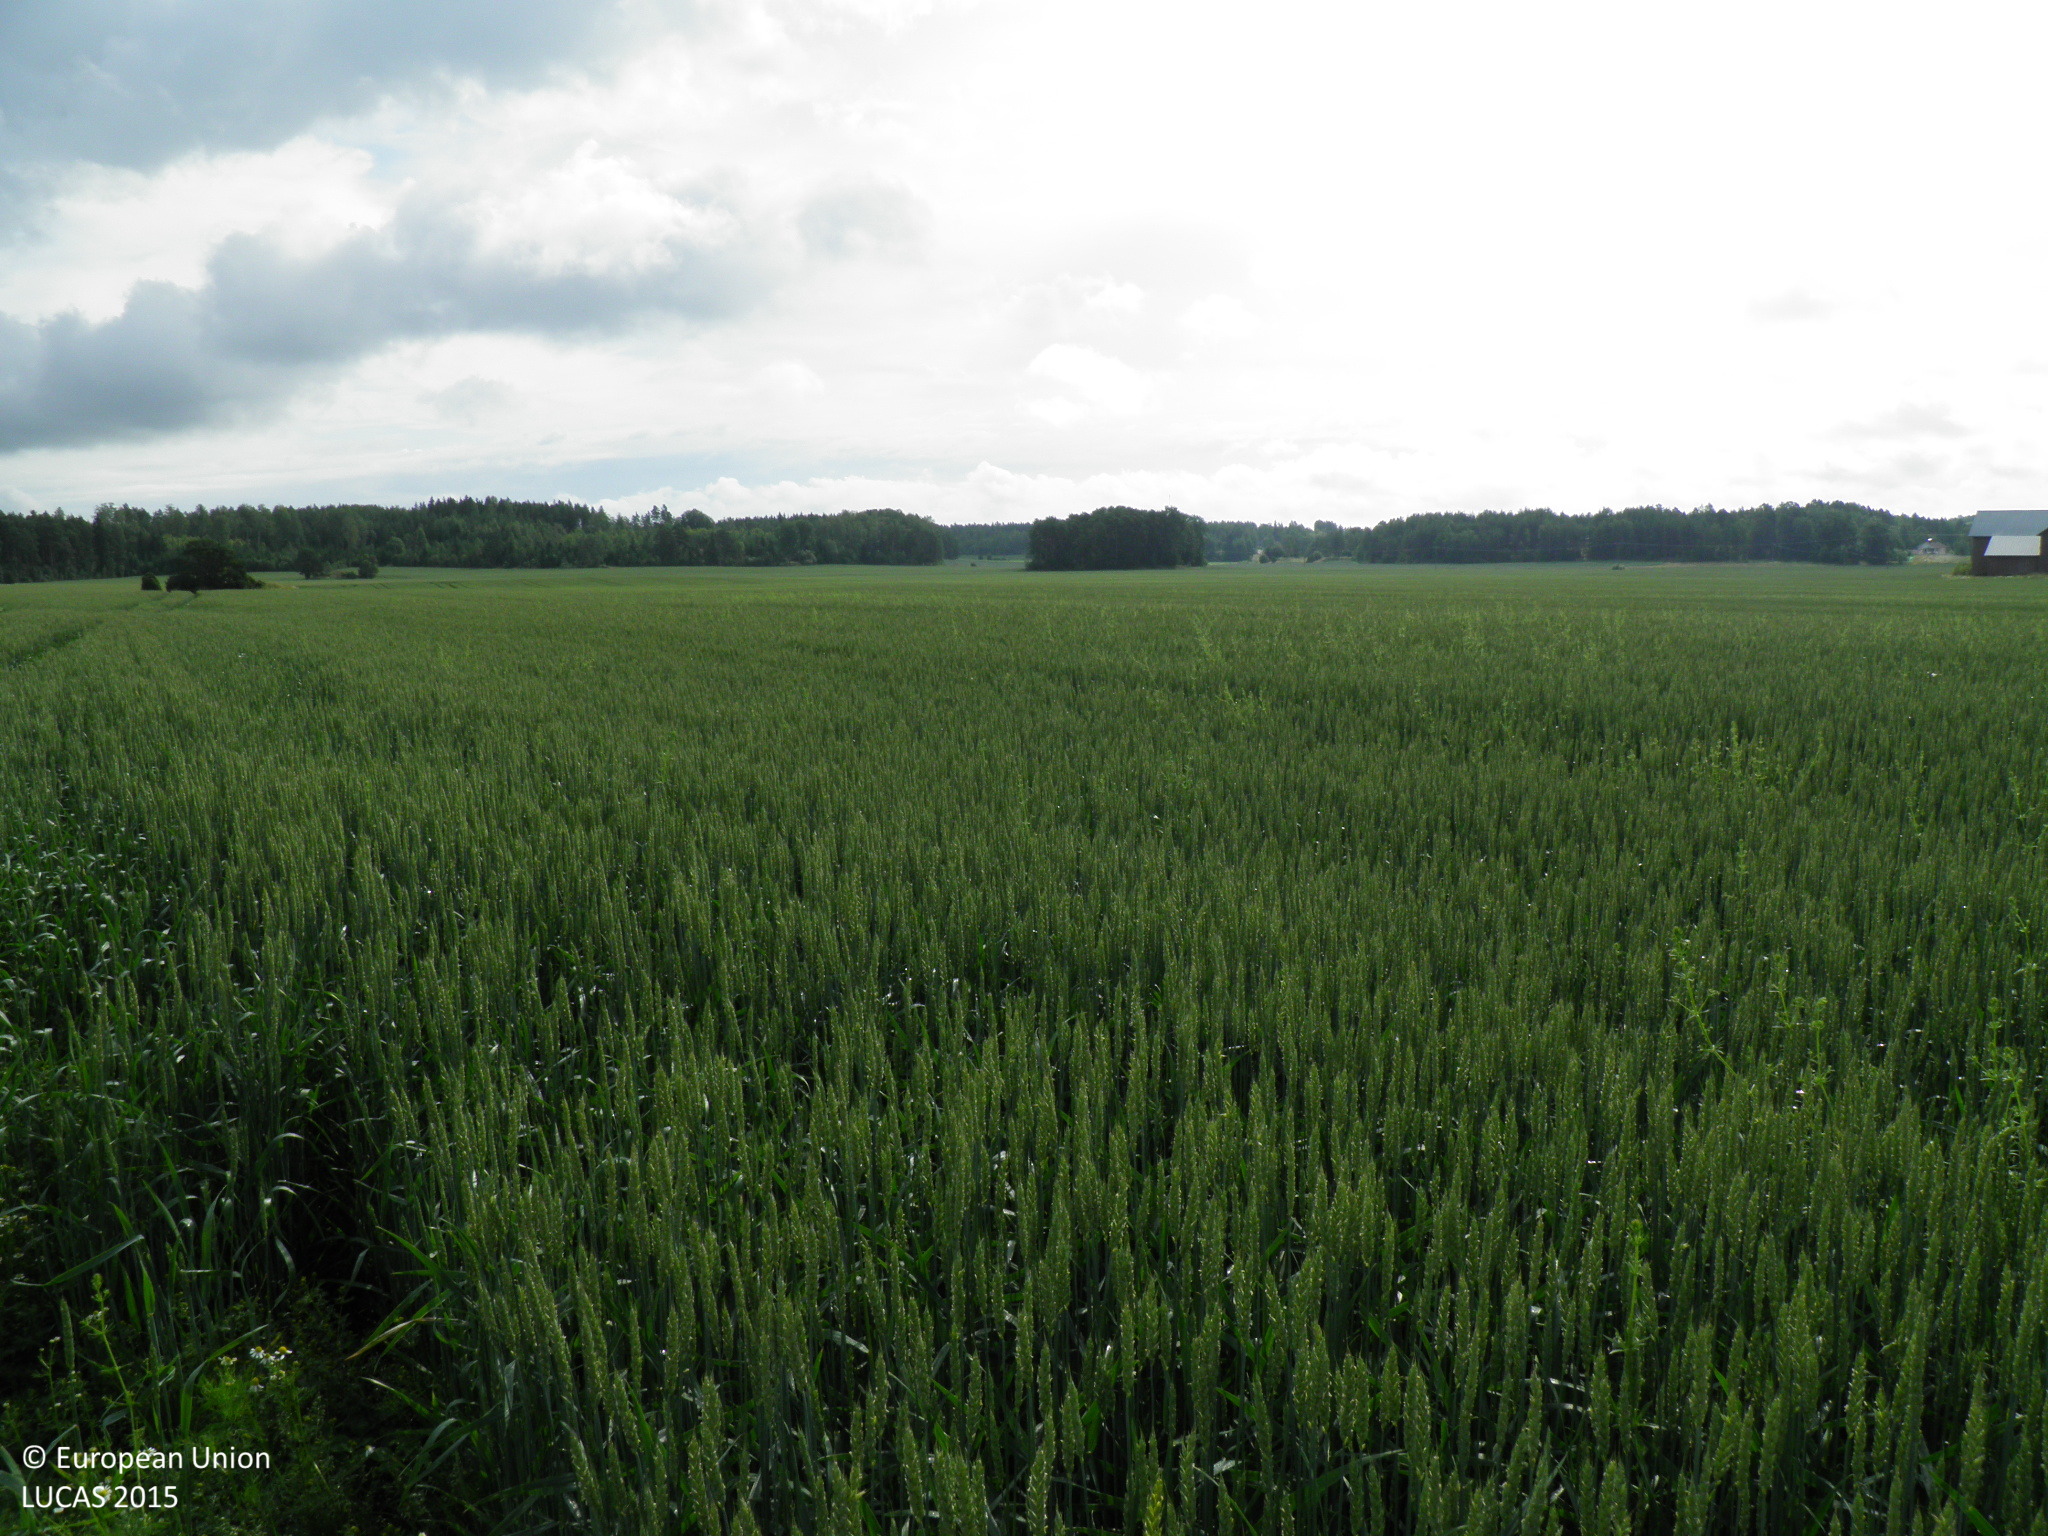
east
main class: Cropland
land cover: Common wheat
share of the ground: > 75 %
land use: Agriculture (excluding fallow land and kitchen gardens)
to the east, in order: Common wheat
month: July
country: FI
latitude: 60.6867
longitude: 21.5740
